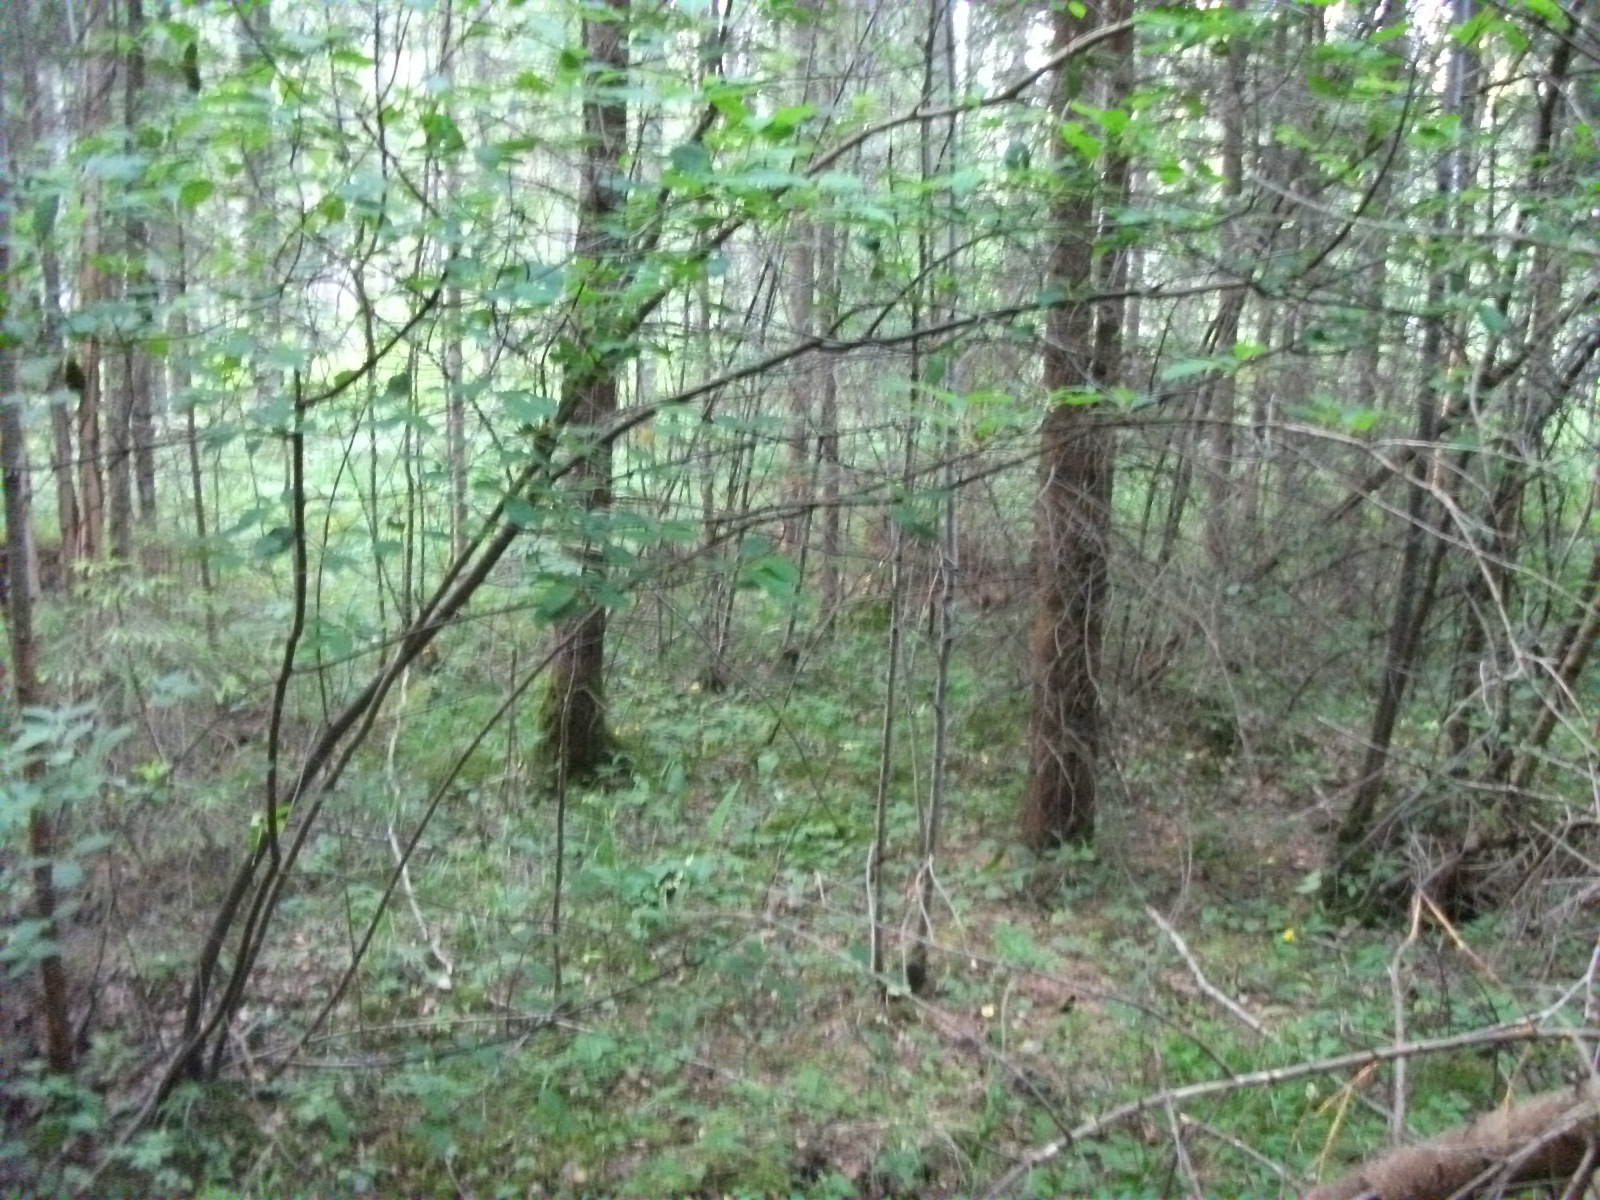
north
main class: Woodland
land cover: Spruce dominated coniferous woodland
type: hemiboreal forest and nemoral coniferous forest and mixed broadleaved-coniferous forest
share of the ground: > 75 %
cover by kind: coniferous forest trees 80 %, herbaceous plants 10 %, lichens and mosses 10 %
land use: Forestry
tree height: > 5 m
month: July
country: LV
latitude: 56.7877
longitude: 26.4659
